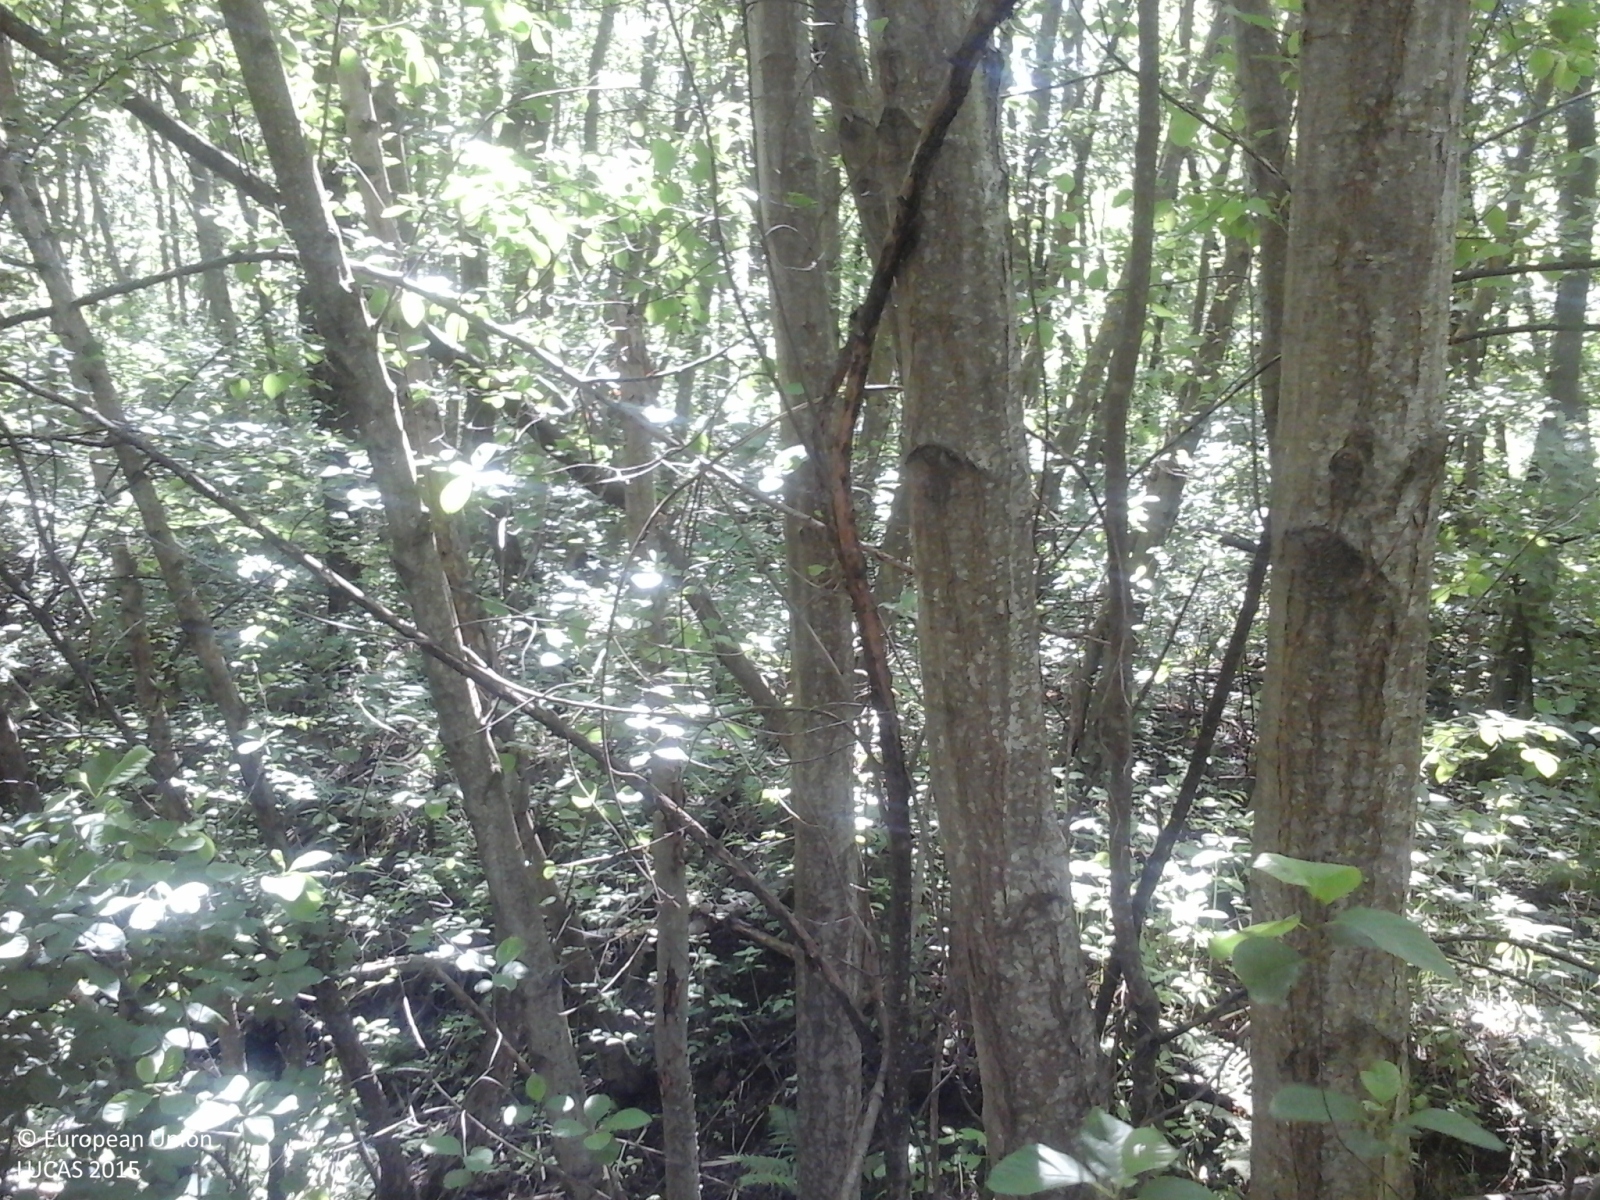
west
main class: Woodland
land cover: Broadleaved woodland
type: mesophytic deciduous forest
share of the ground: > 75 %
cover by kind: broadleaved forest trees 100 %
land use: Forestry
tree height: > 5 m
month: May
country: IT
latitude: 46.6195
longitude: 10.6391
